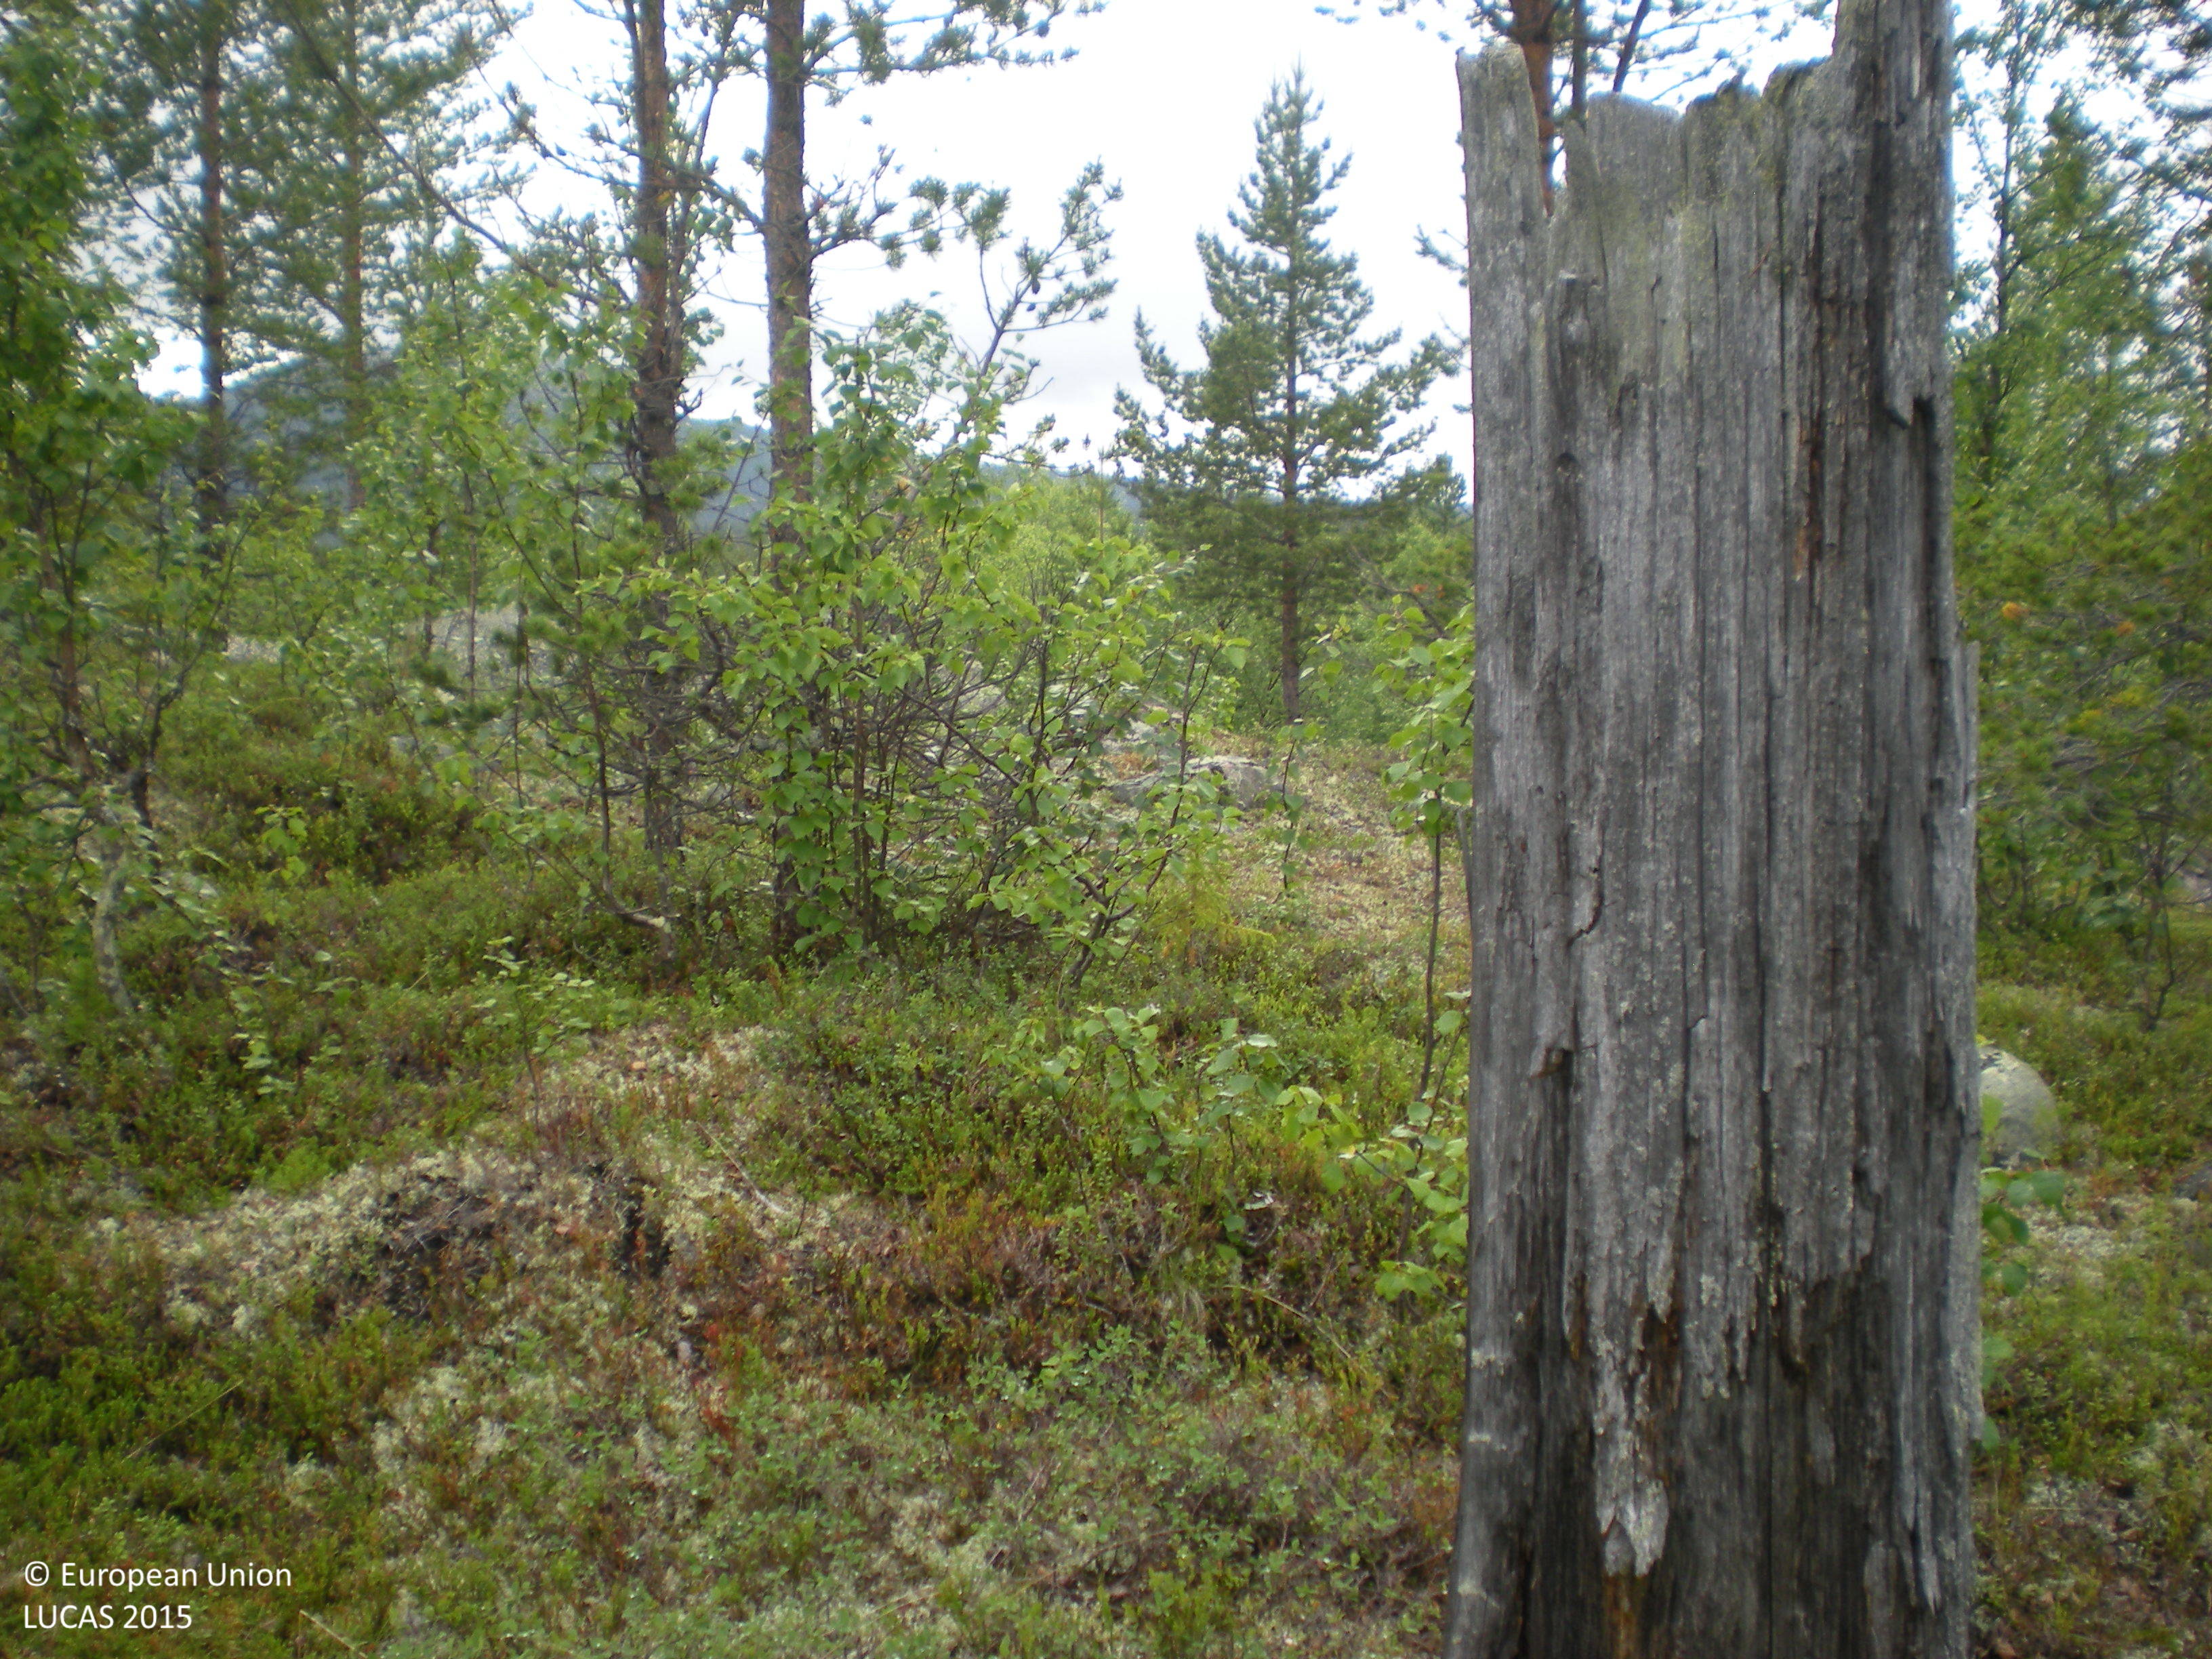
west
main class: Woodland
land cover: Pine dominated mixed woodland
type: boreal forest
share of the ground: 50 - 75 %
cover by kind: coniferous forest trees 45 %, shrubs 20 %, broadleaved forest trees 15 %, lichens and mosses 10 %, consolidated bare surface 10 %
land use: Forestry
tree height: > 5 m
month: August
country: SE
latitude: 66.2134
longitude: 18.0192
